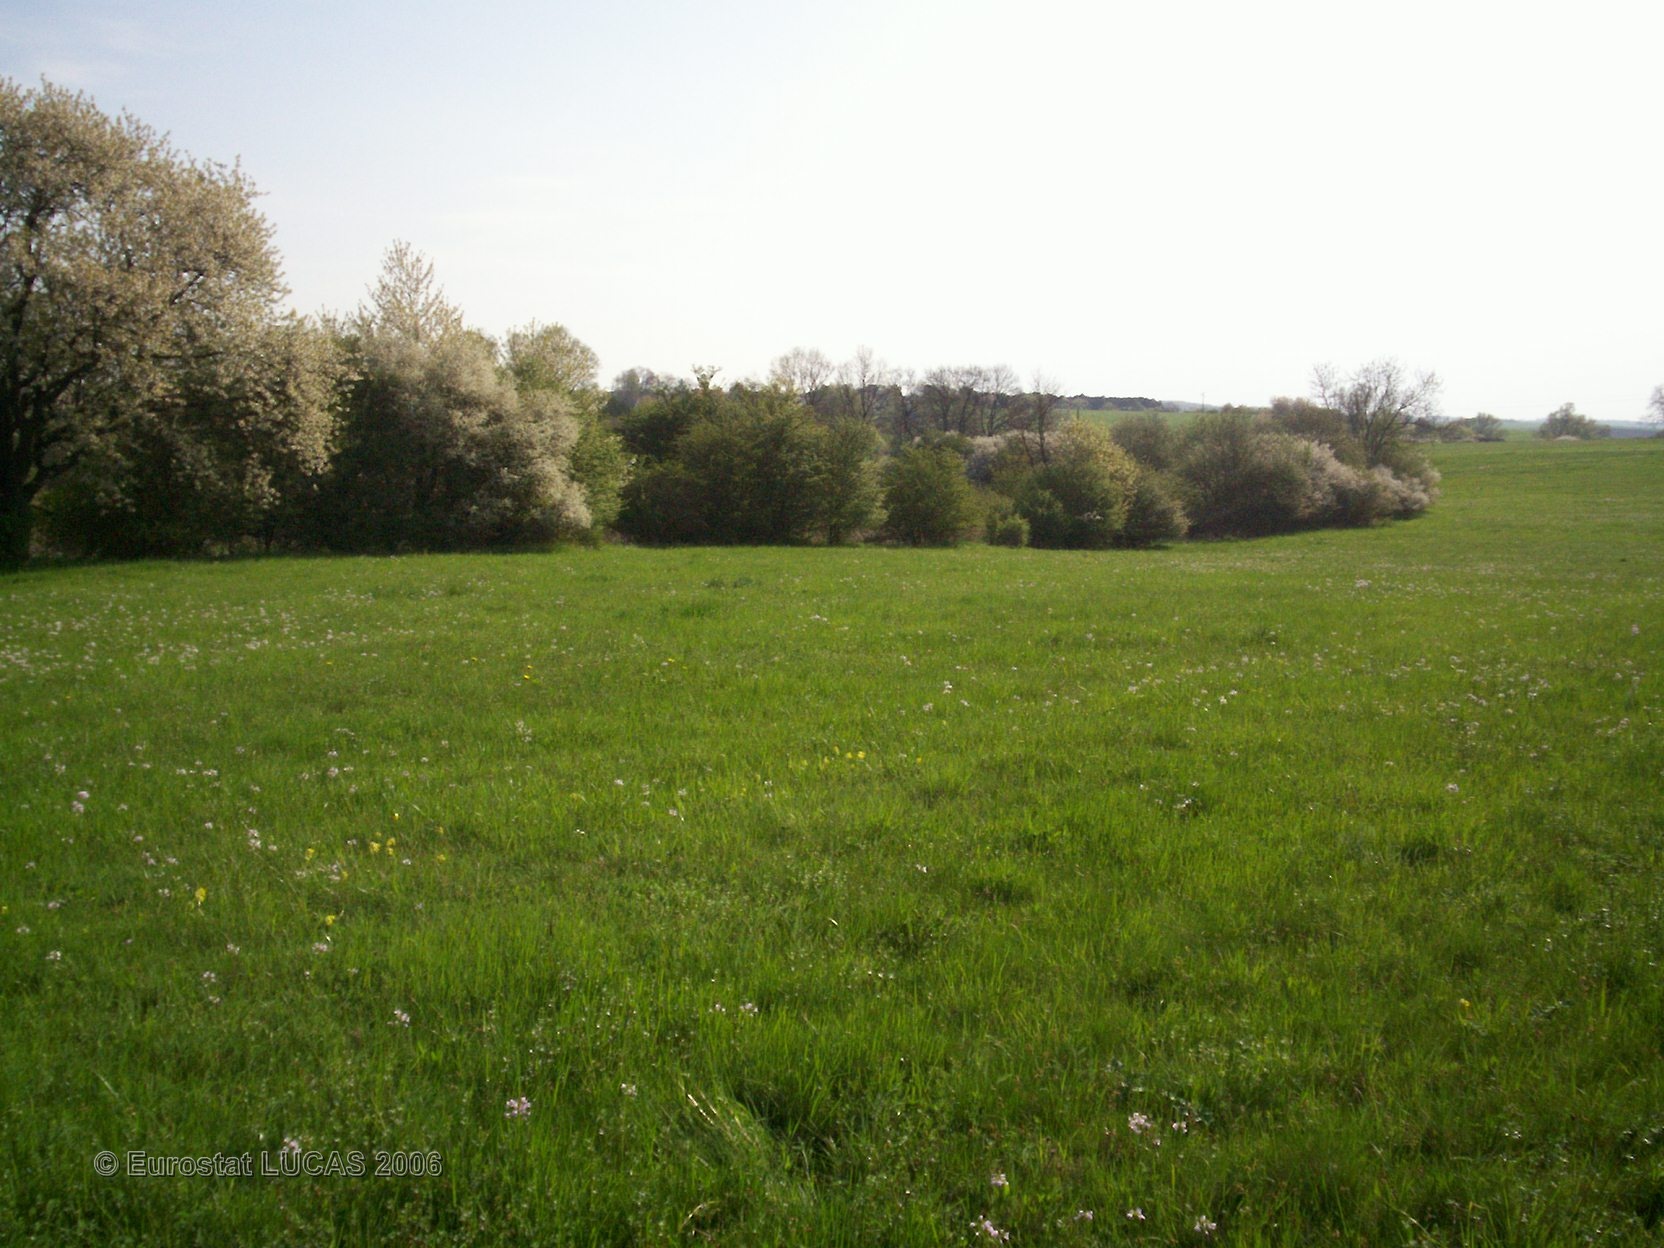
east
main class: Grassland
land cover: Grassland without tree/shrub cover
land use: Agriculture (excluding fallow land and kitchen gardens)
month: April
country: FR
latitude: 49.0448
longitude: 6.9221
